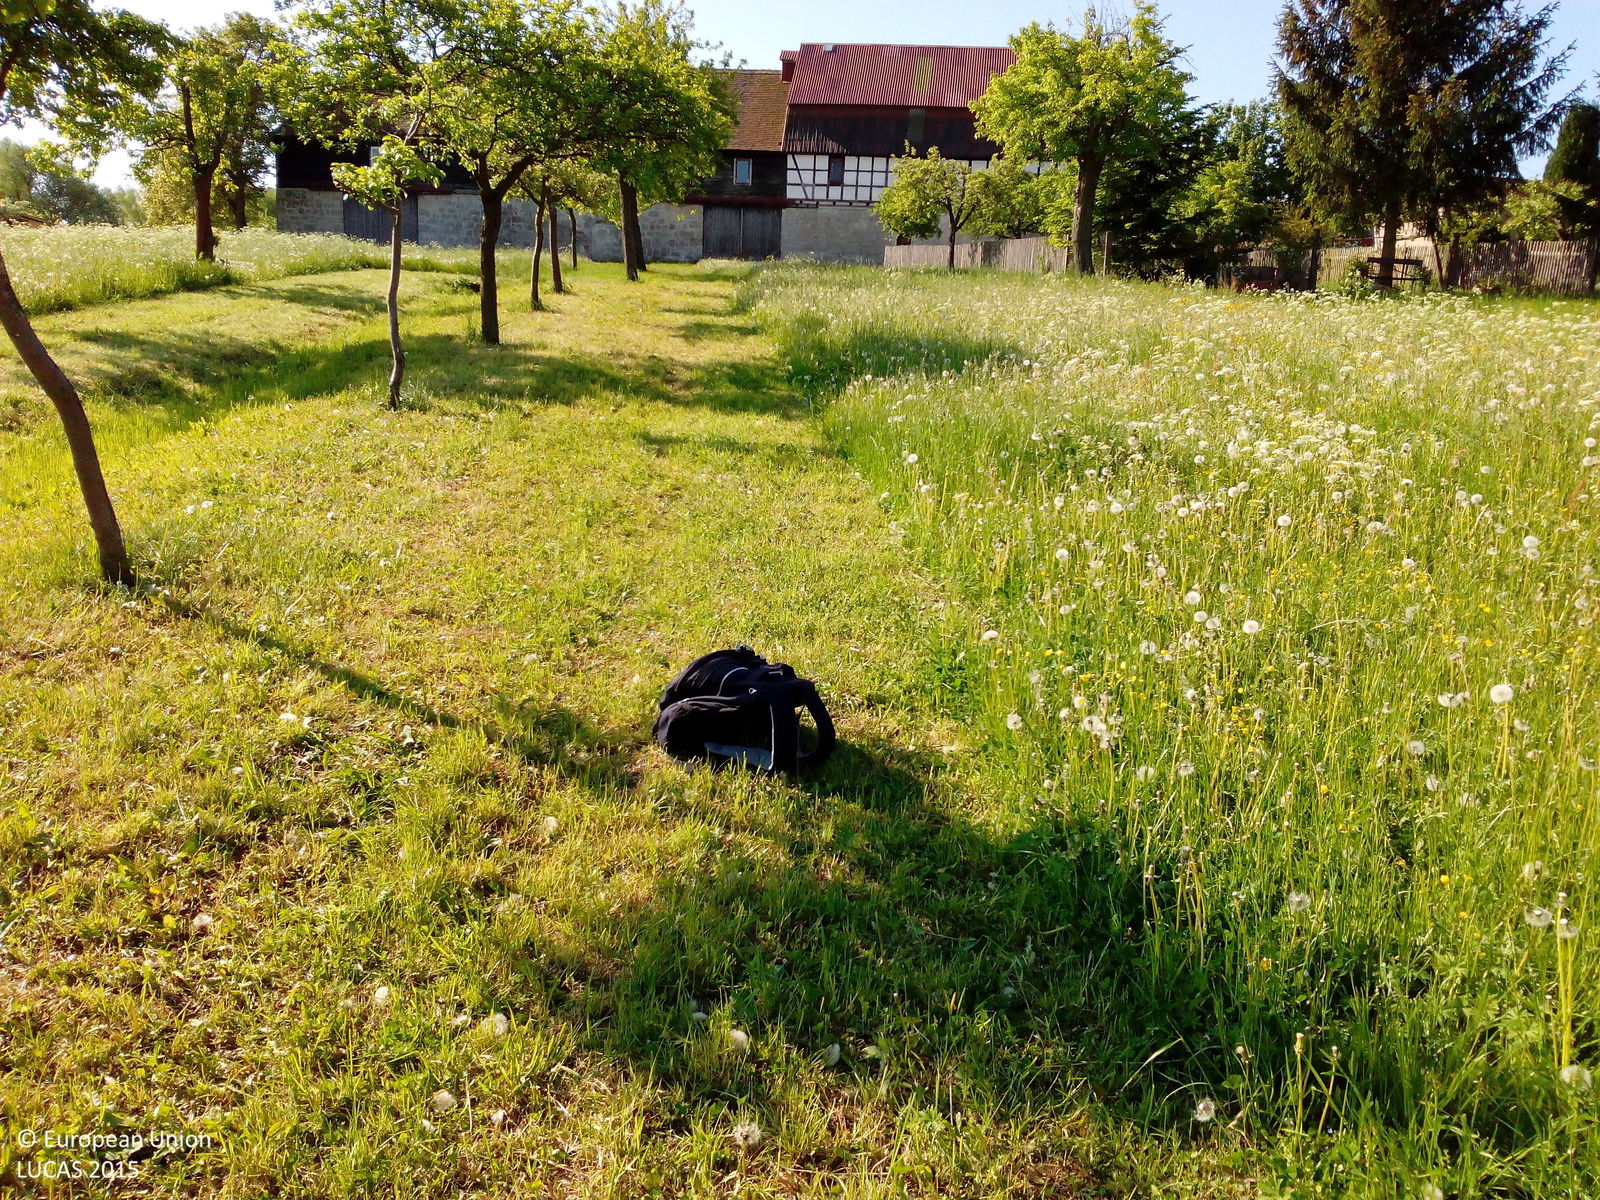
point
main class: Cropland
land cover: Apple fruit
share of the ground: 25 - 50 %
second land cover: Grassland without tree/shrub cover
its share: > 75 %
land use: Agriculture (excluding fallow land and kitchen gardens)
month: May
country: DE
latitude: 50.8582
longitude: 11.4629
